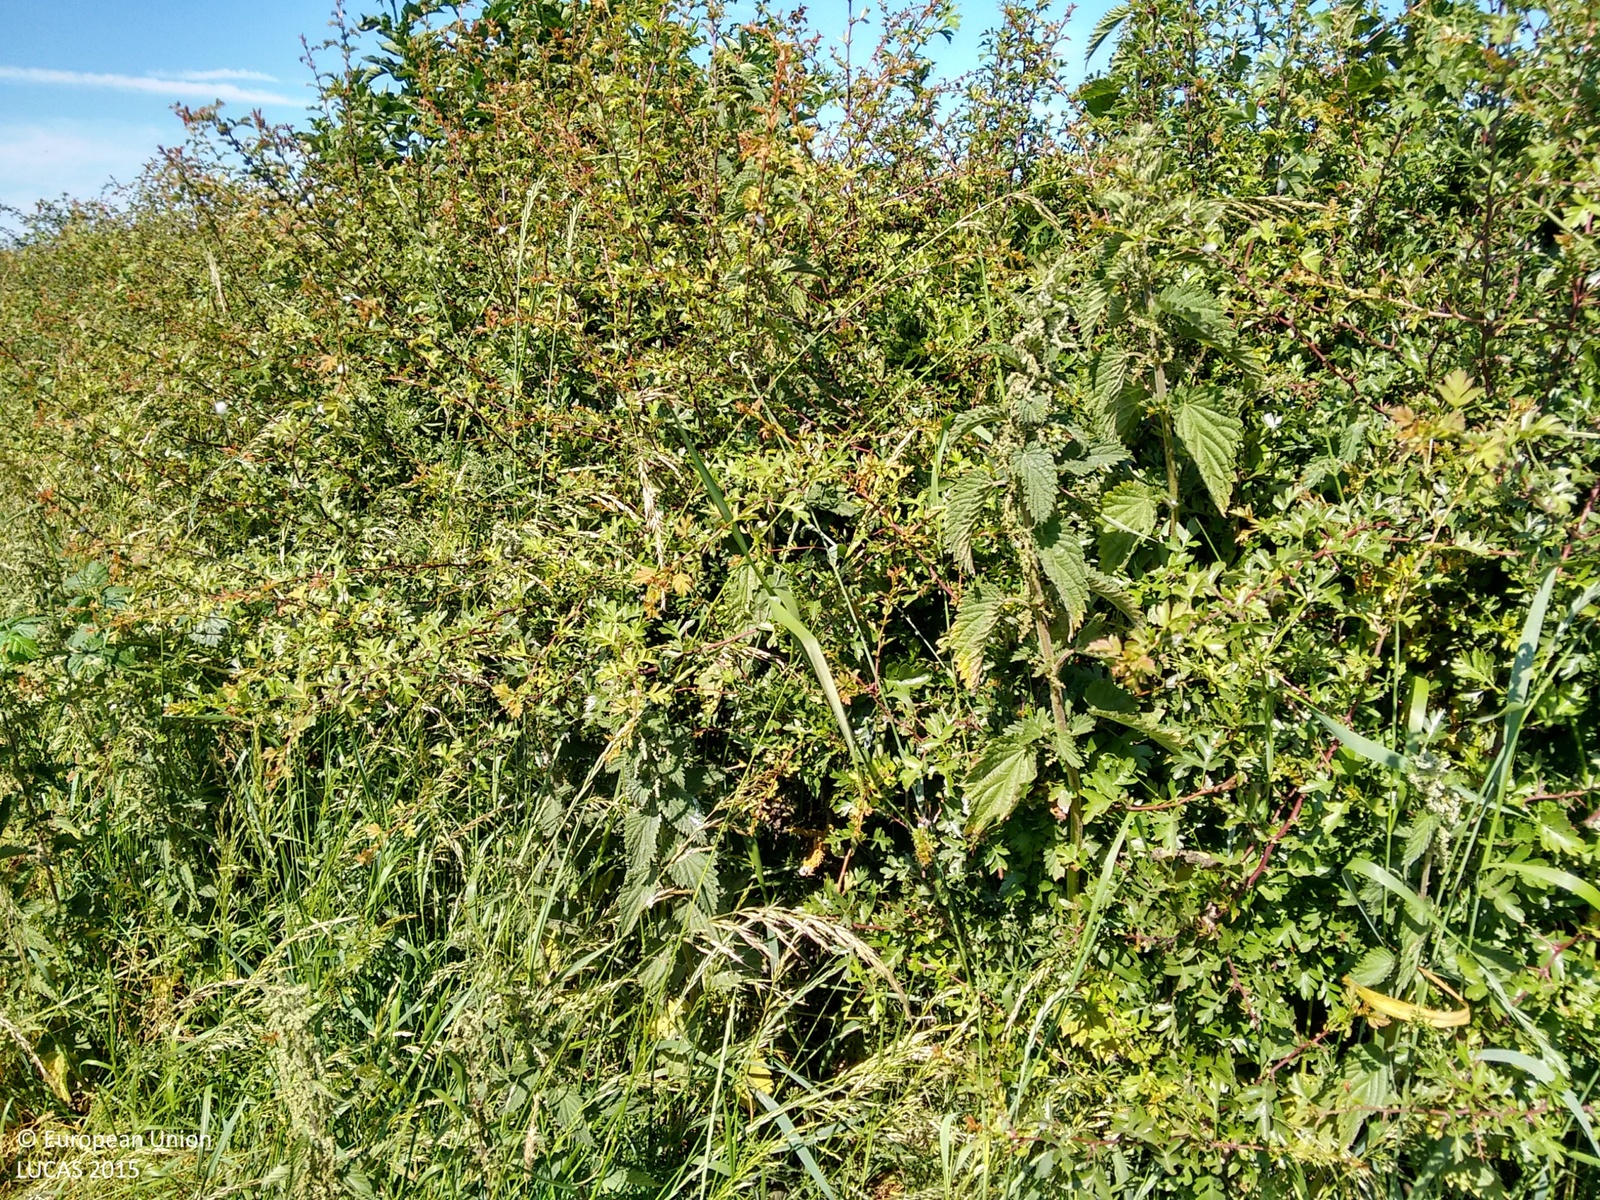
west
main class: Cropland
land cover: Common wheat
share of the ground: > 75 %
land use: Agriculture (excluding fallow land and kitchen gardens)
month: July
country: GB
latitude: 52.8975
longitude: -0.8191
